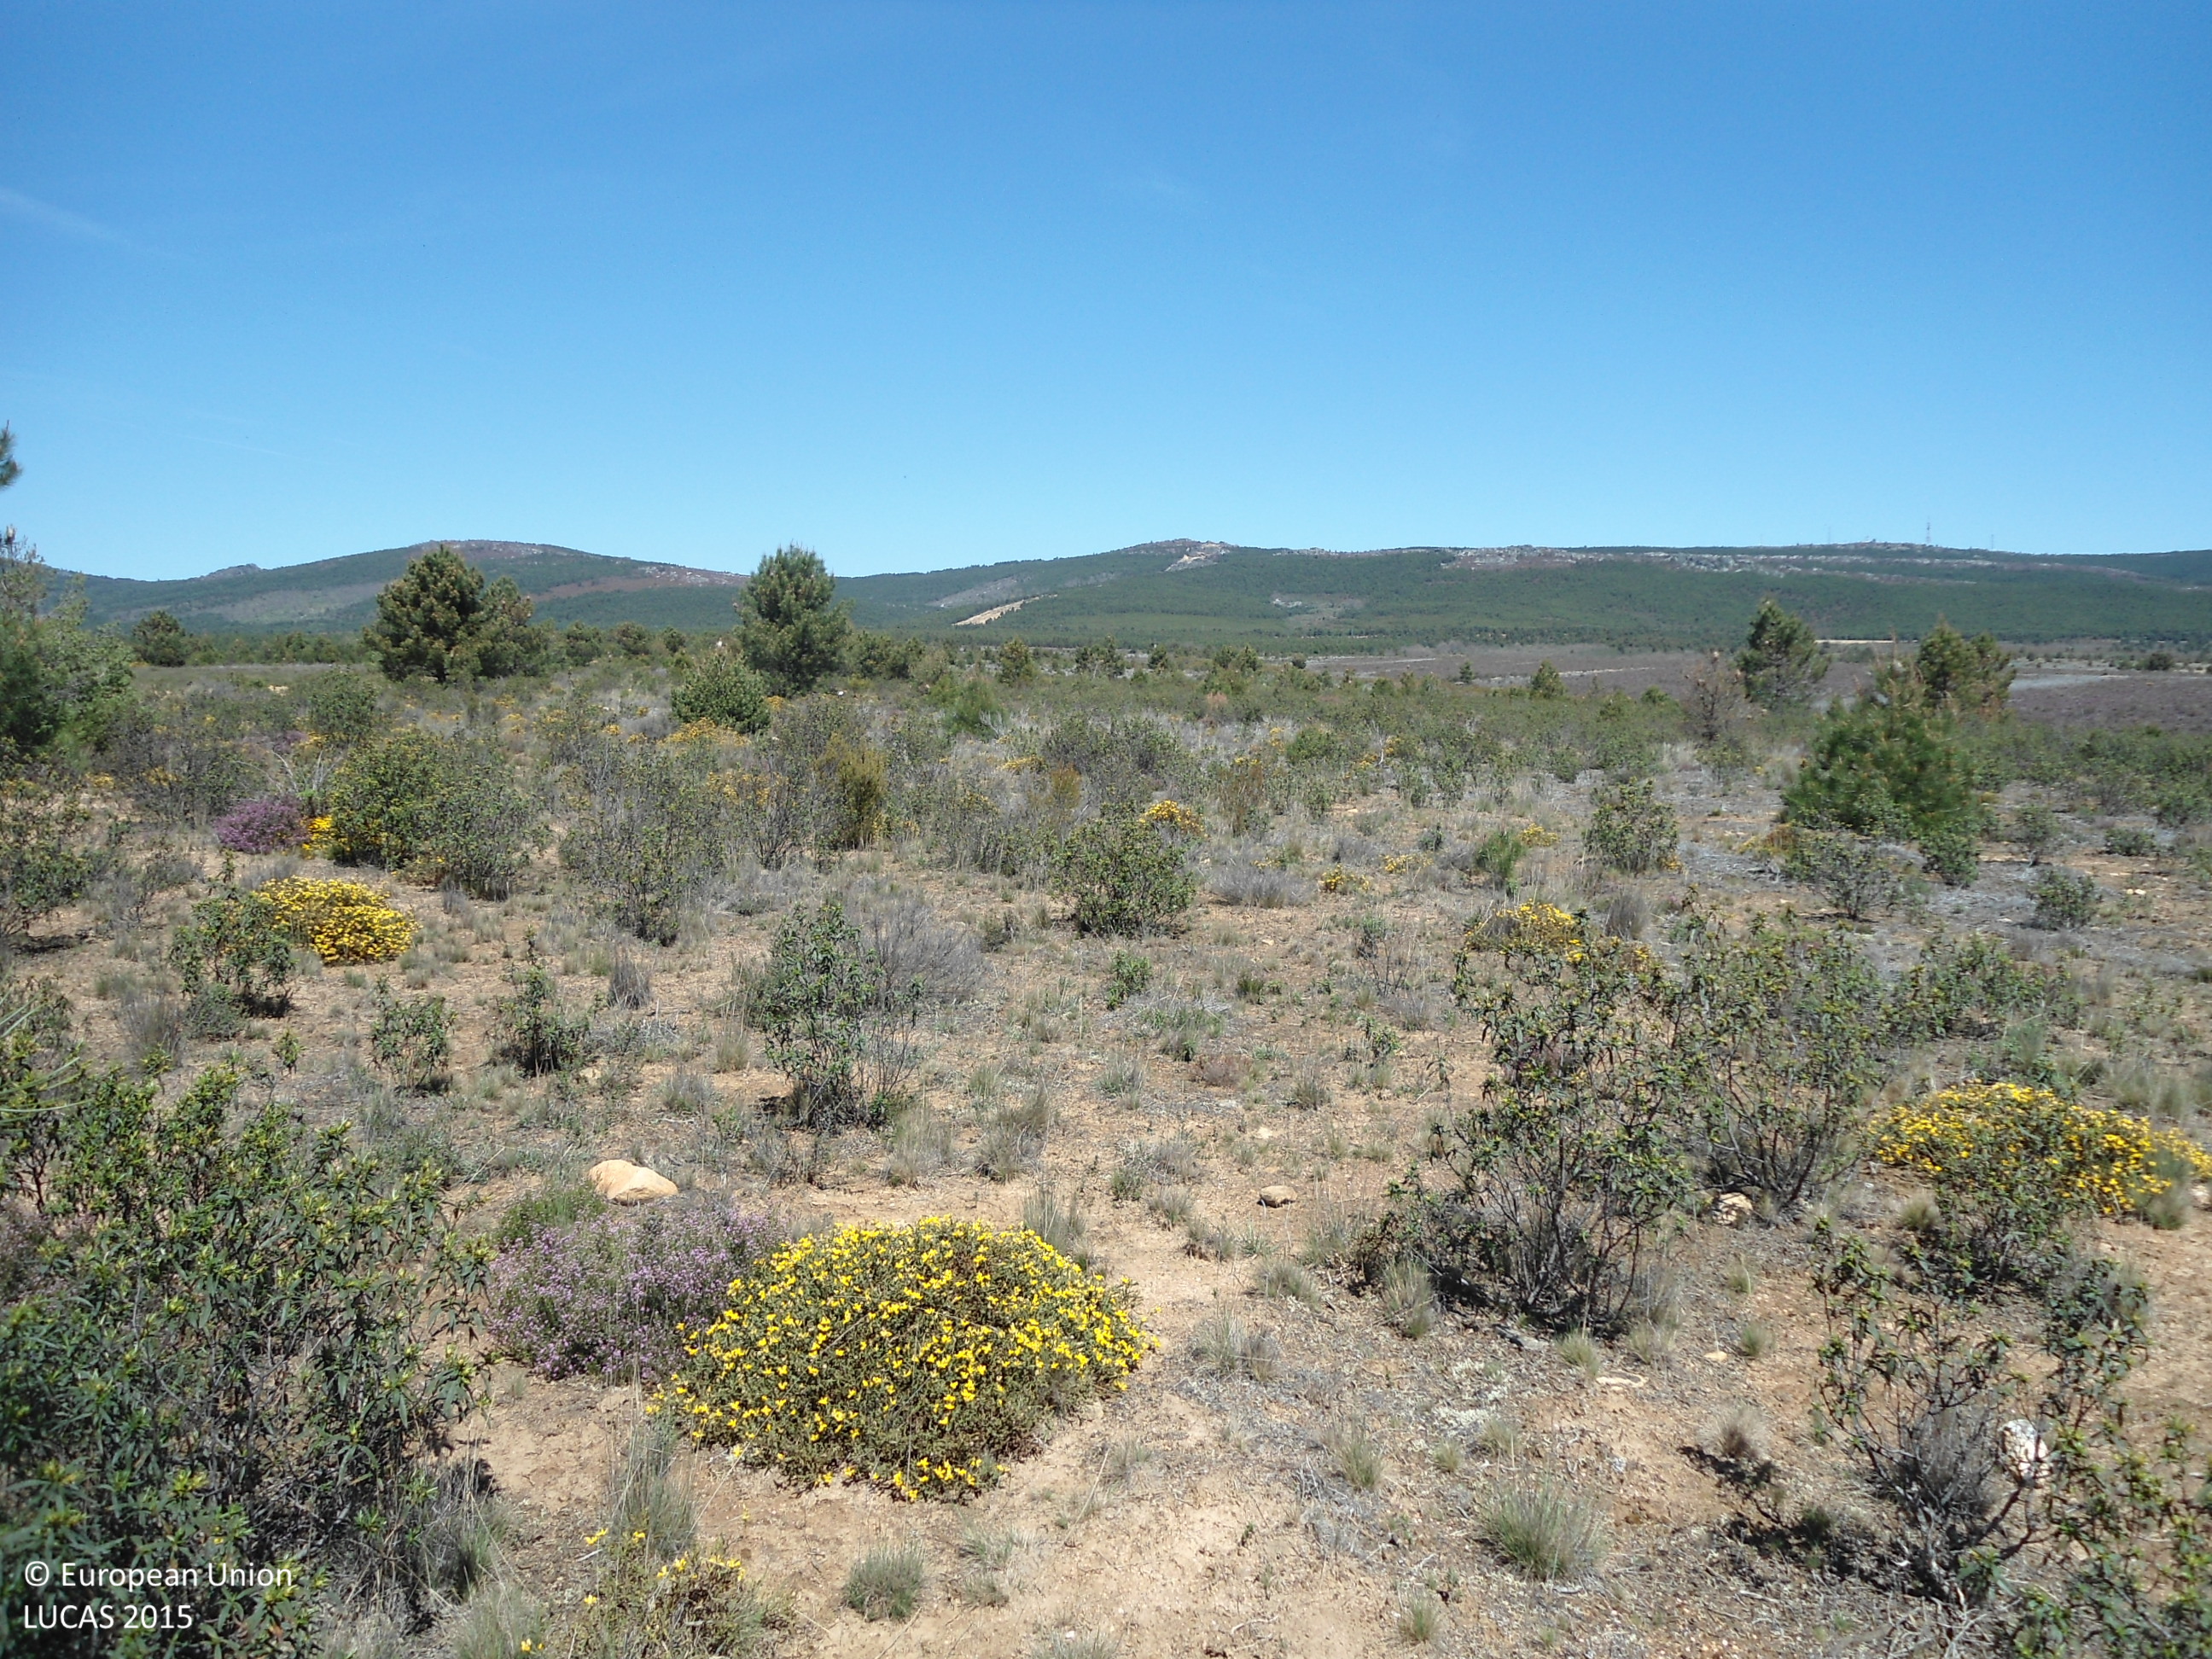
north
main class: Shrubland
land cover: Shrubland with sparse tree cover
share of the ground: > 75 %
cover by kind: shrubs 75 %, herbaceous plants 20 %, coniferous forest trees 5 %
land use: Semi-natural and natural areas not in use
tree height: < 5 m
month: April
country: ES
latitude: 41.8694
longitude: -6.3331
